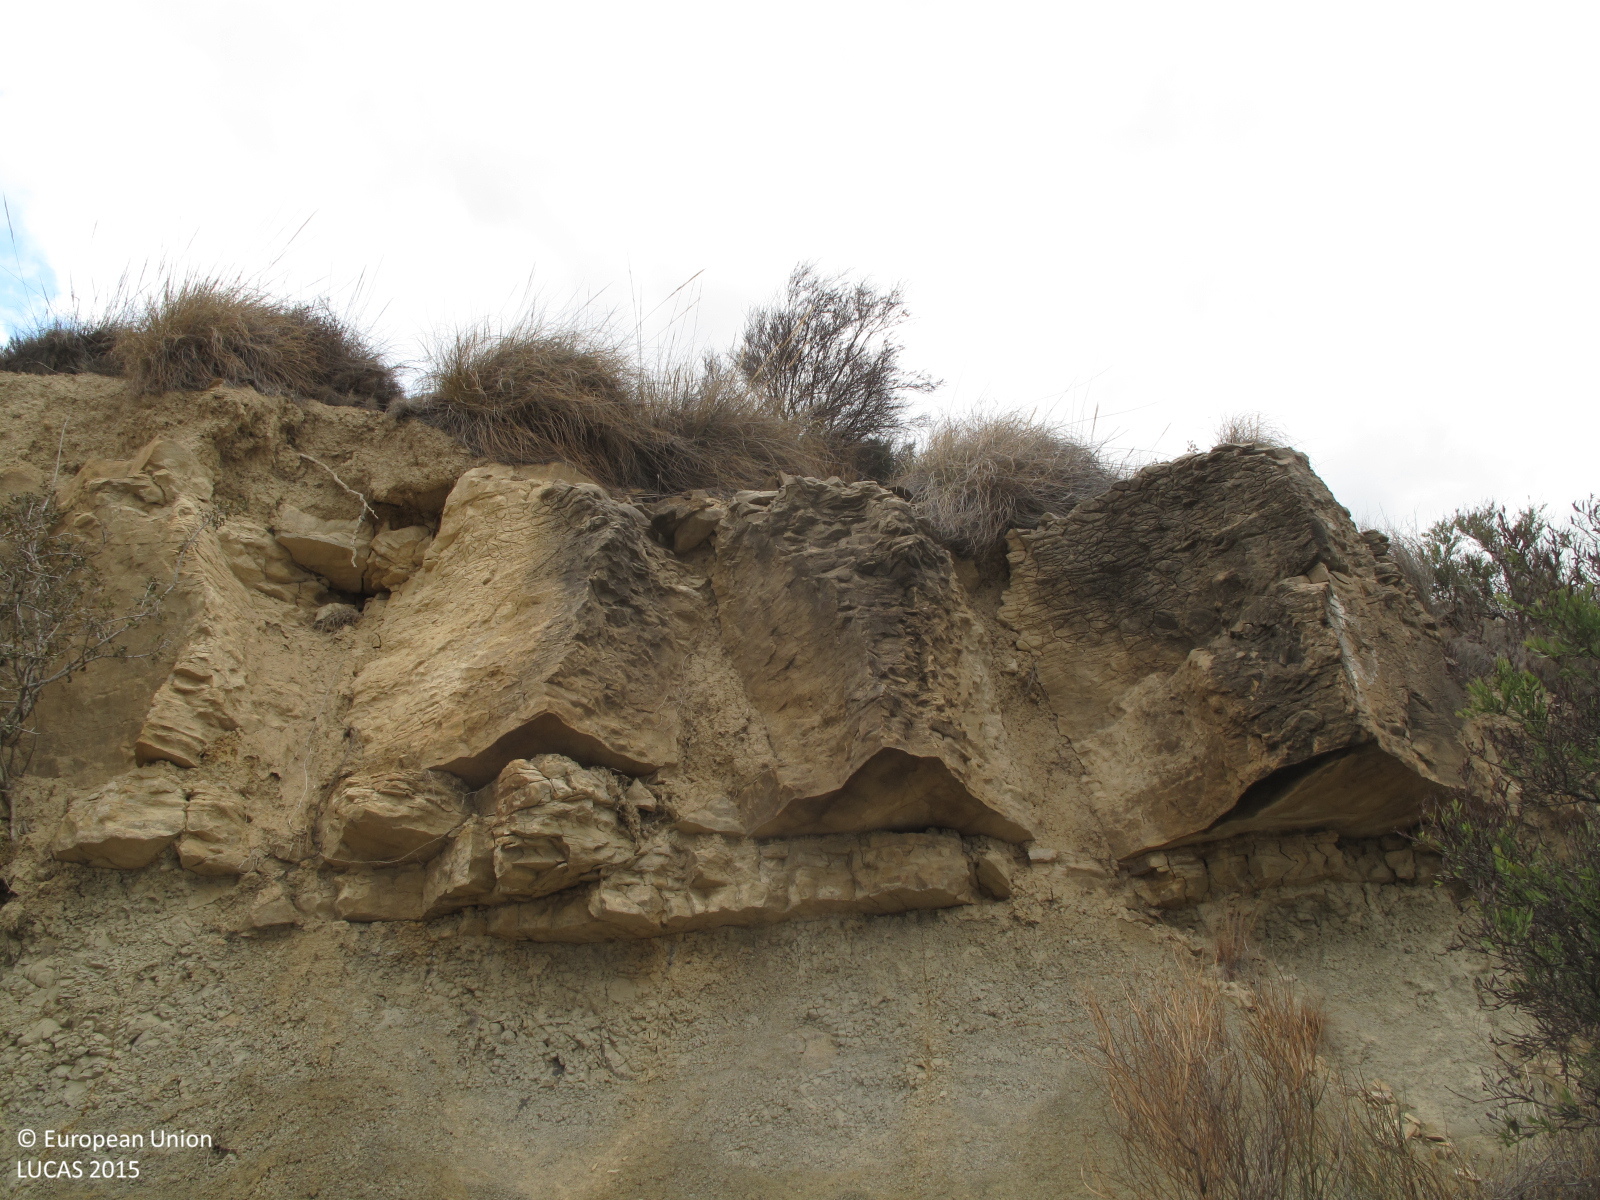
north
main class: Shrubland
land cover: Shrubland with sparse tree cover
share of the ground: 25 - 50 %
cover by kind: herbaceous plants 60 %, shrubs 25 %, consolidated bare surface 10 %, coniferous forest trees 5 %
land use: Semi-natural and natural areas not in use
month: May
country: ES
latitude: 38.6459
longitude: 0.0284
